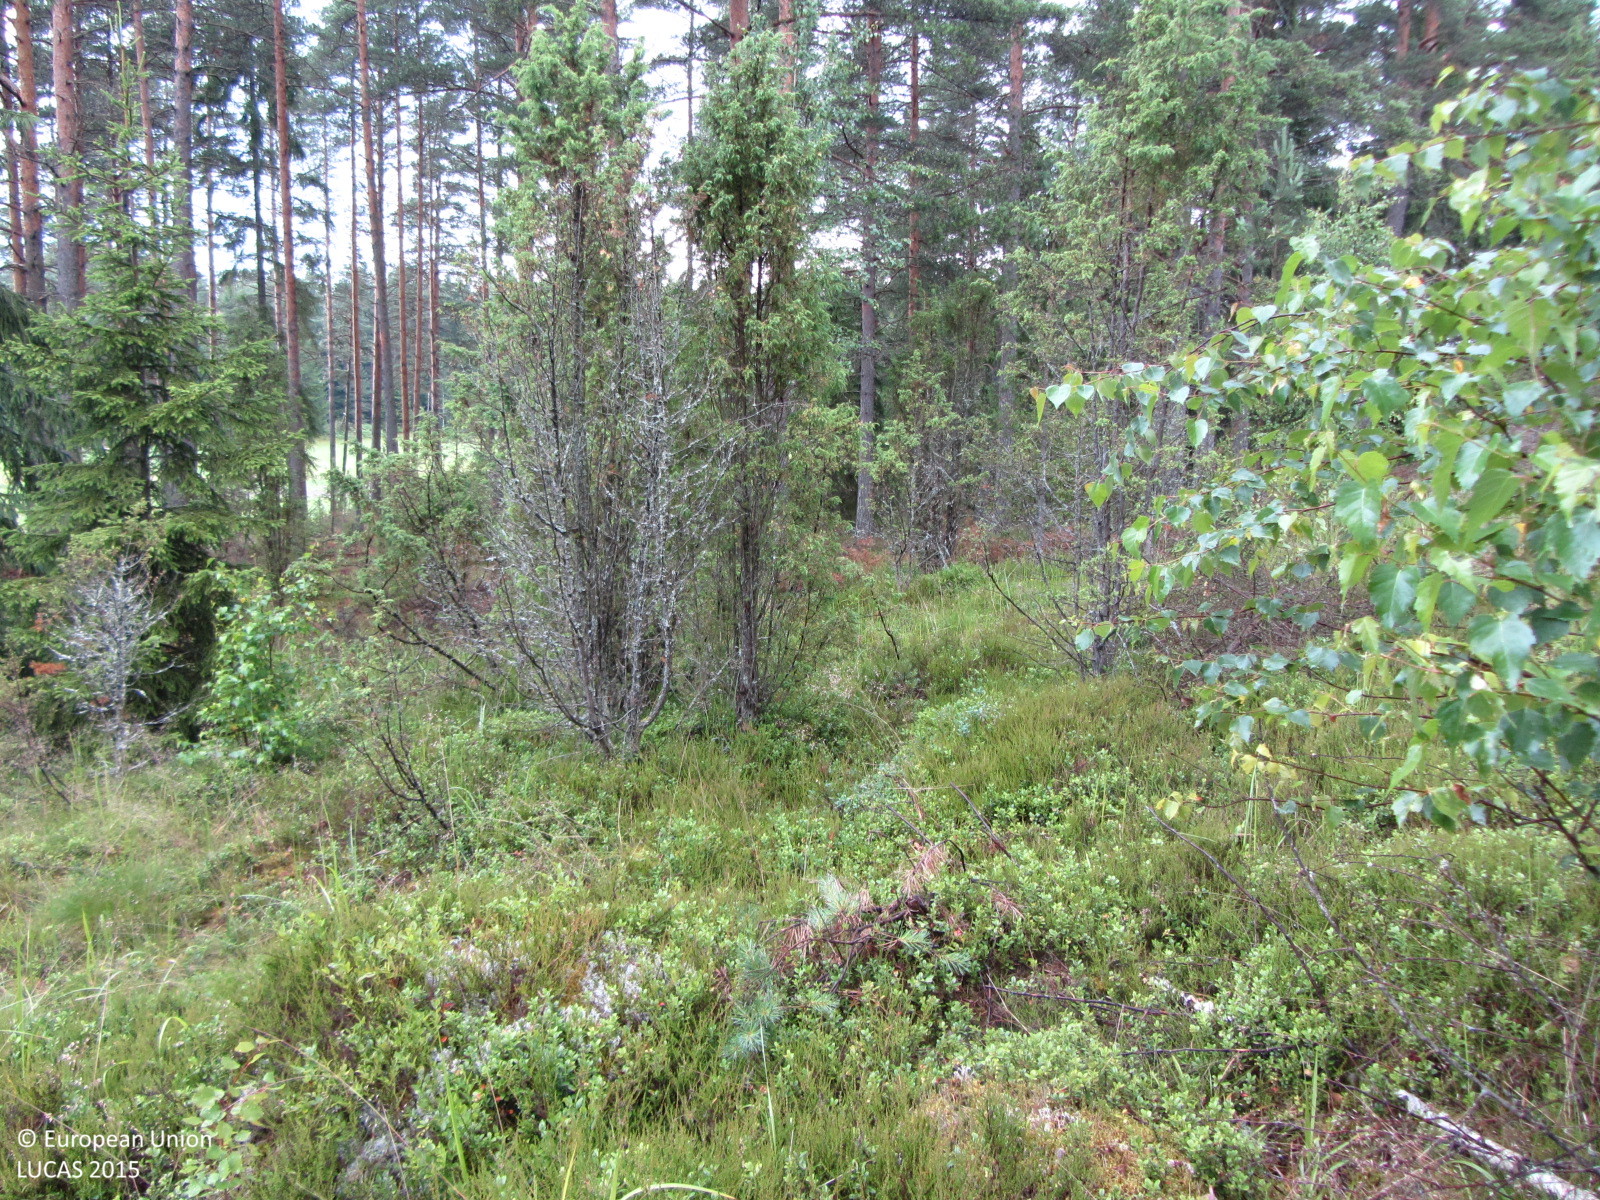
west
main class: Shrubland
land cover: Shrubland with sparse tree cover
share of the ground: > 75 %
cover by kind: shrubs 90 %, broadleaved forest trees 5 %, herbaceous plants 5 %
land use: Electricity, gas and thermal power distribution
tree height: < 5 m
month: July
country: FI
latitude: 60.0756
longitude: 24.2474
